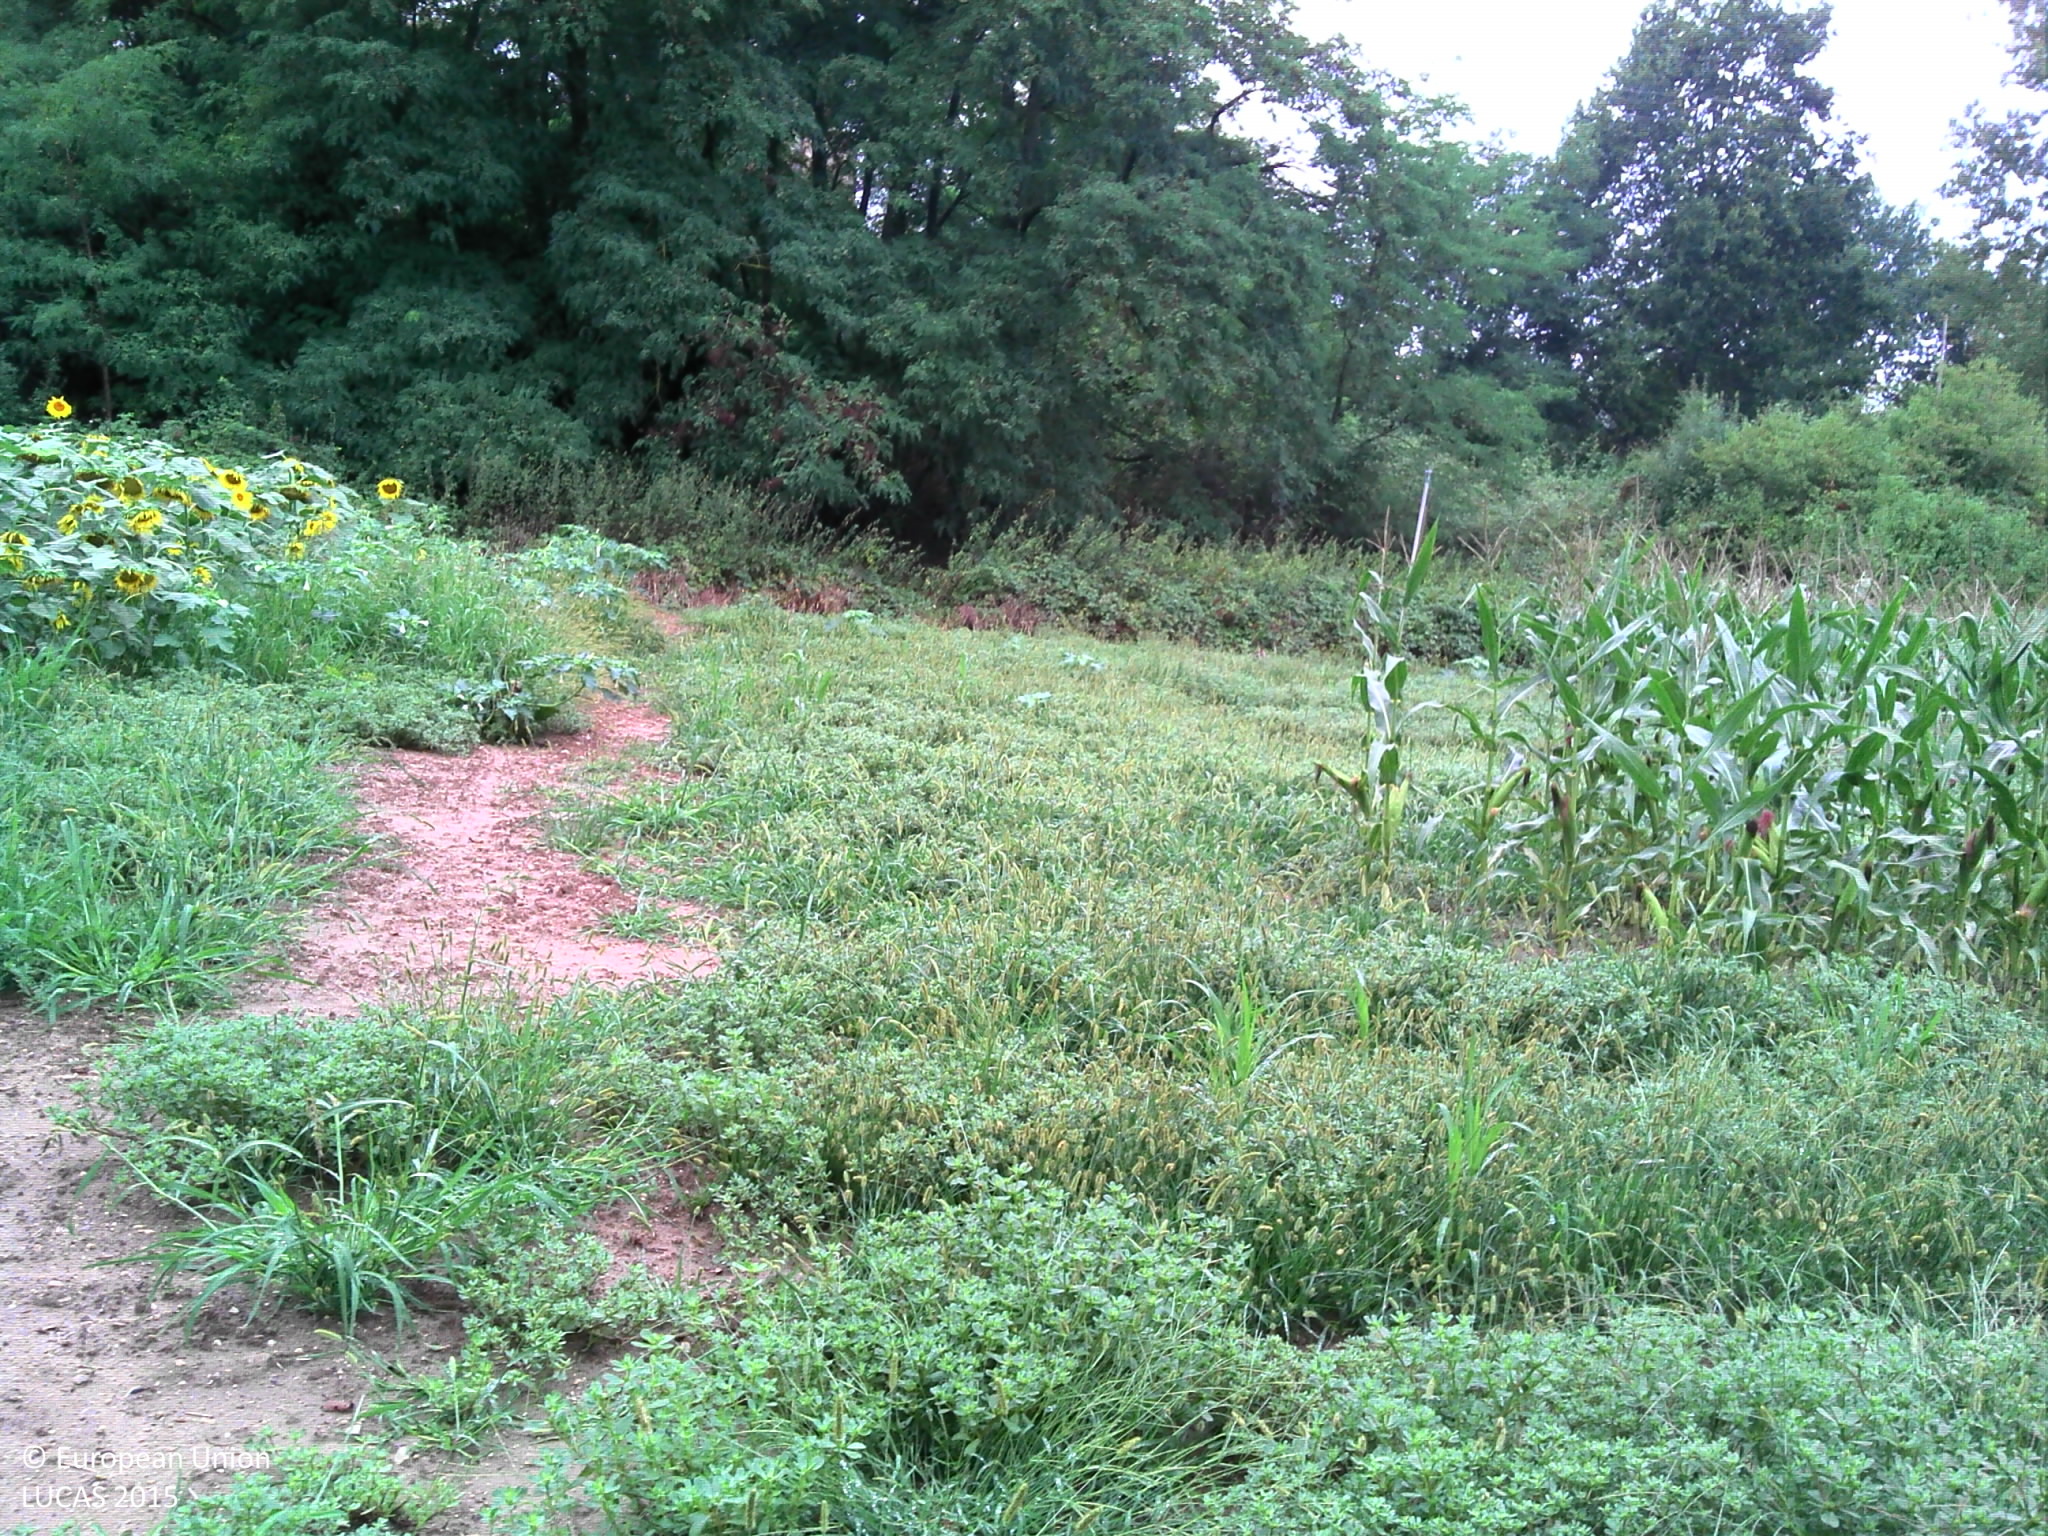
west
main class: Cropland
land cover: Maize
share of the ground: > 75 %
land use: Agriculture (excluding fallow land and kitchen gardens)
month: August
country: FR
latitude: 44.0040
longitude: 1.5326
